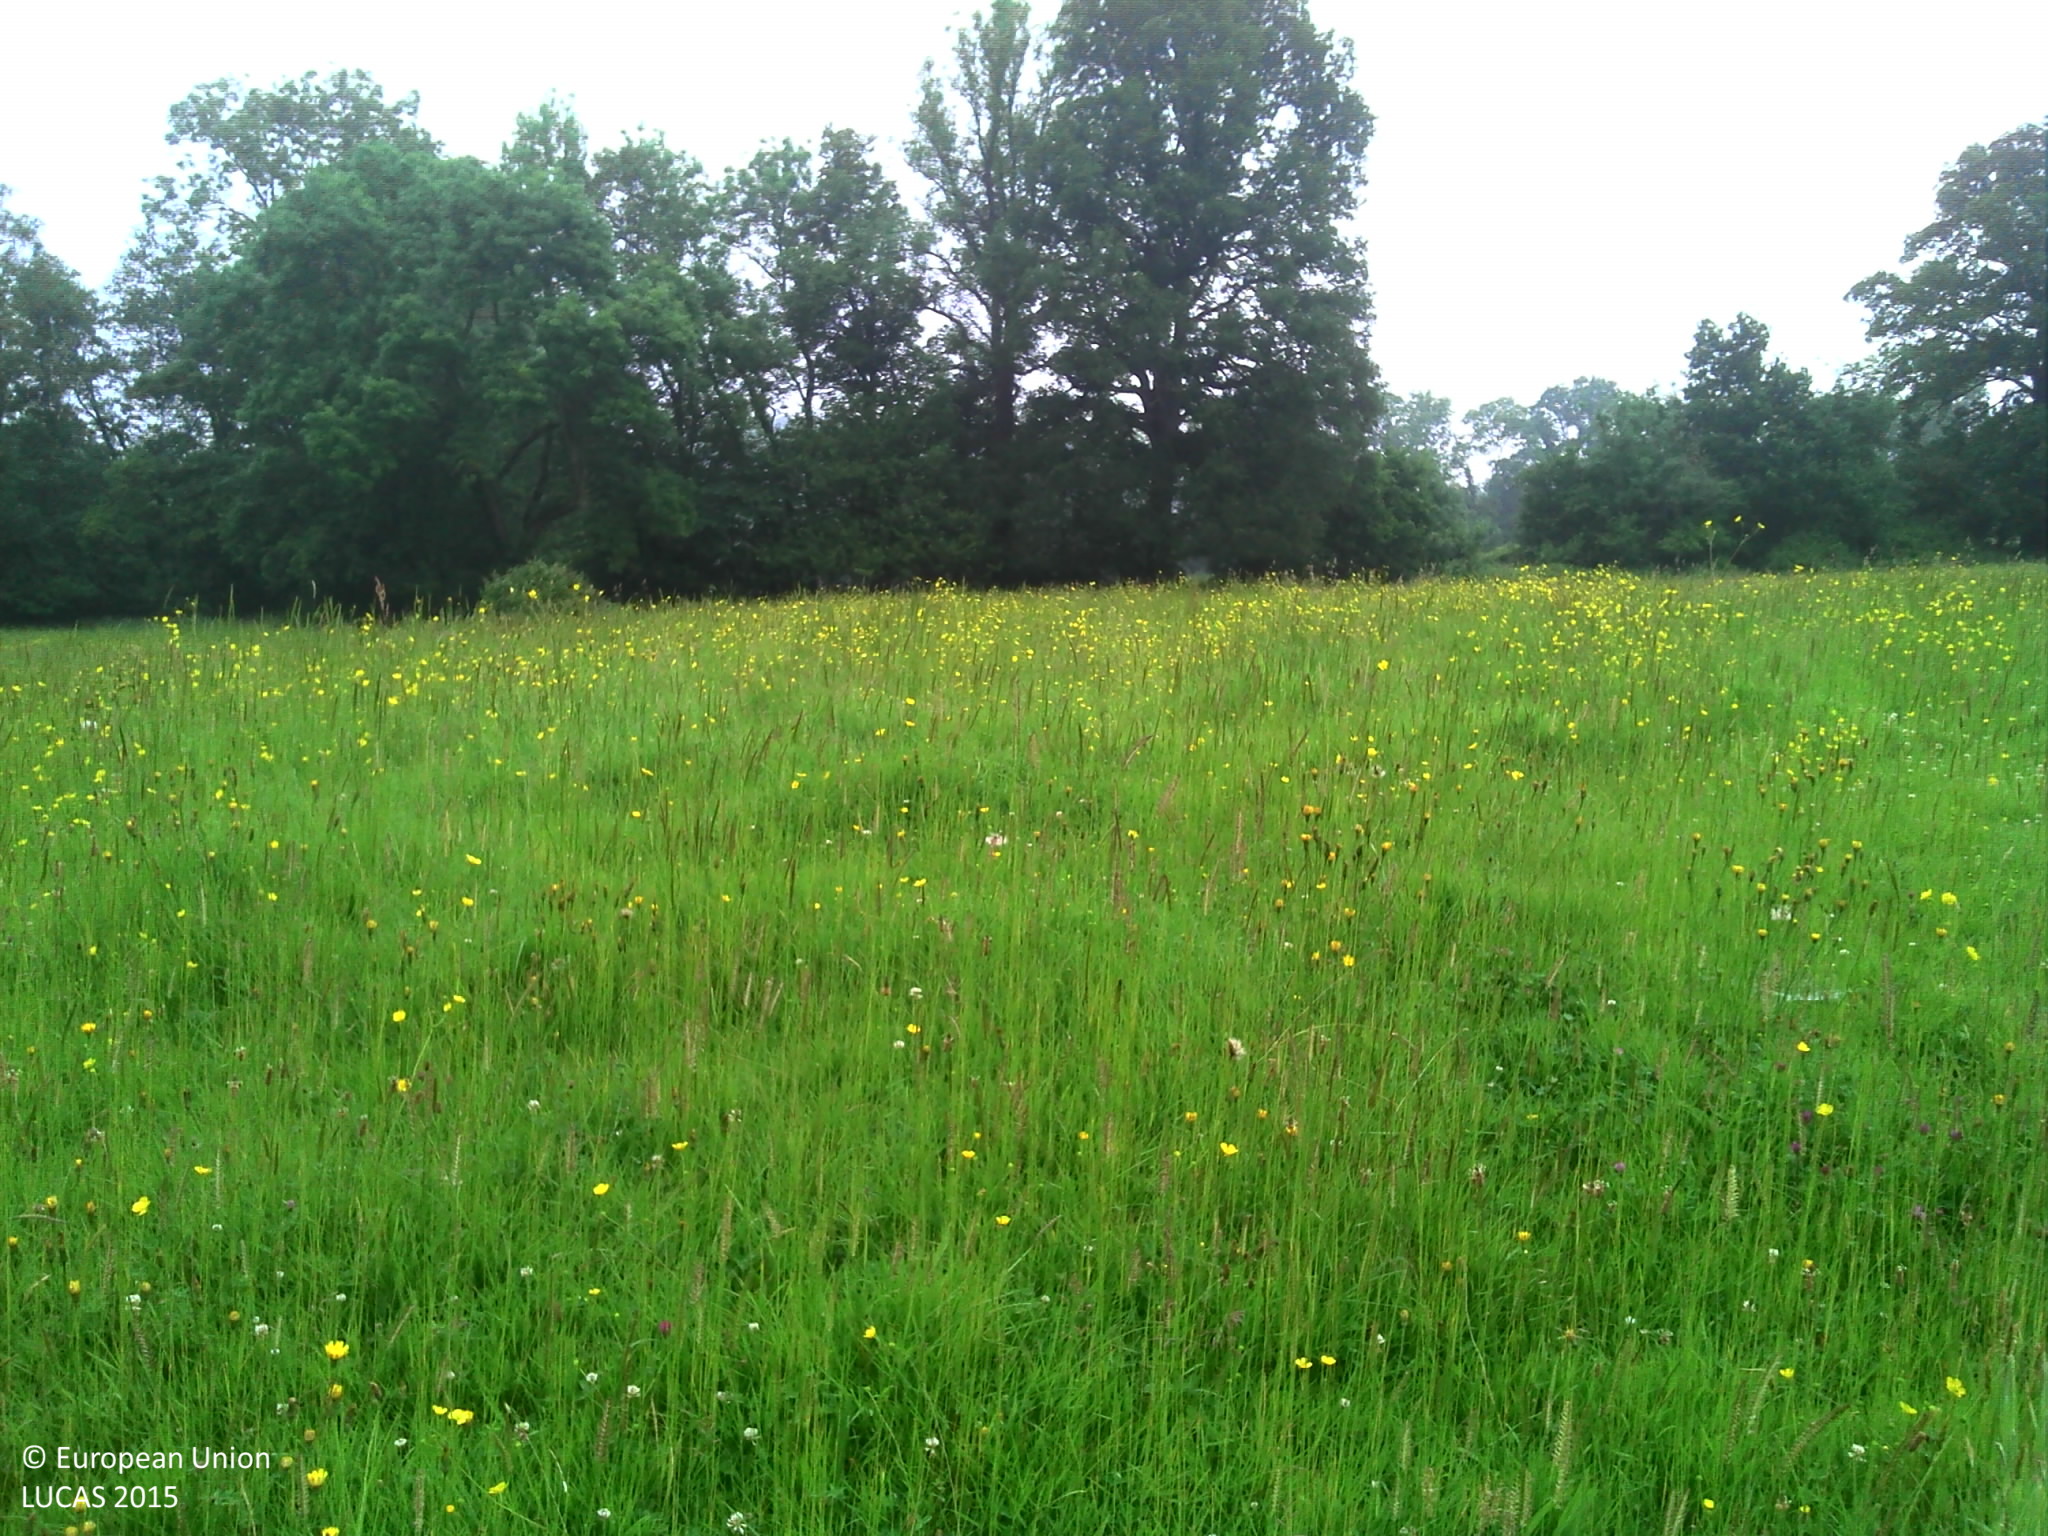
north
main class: Grassland
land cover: Grassland without tree/shrub cover
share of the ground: > 75 %
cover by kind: herbaceous plants 100 %
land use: Agriculture (excluding fallow land and kitchen gardens)
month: June
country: FR
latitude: 49.2549
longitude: 0.0079
